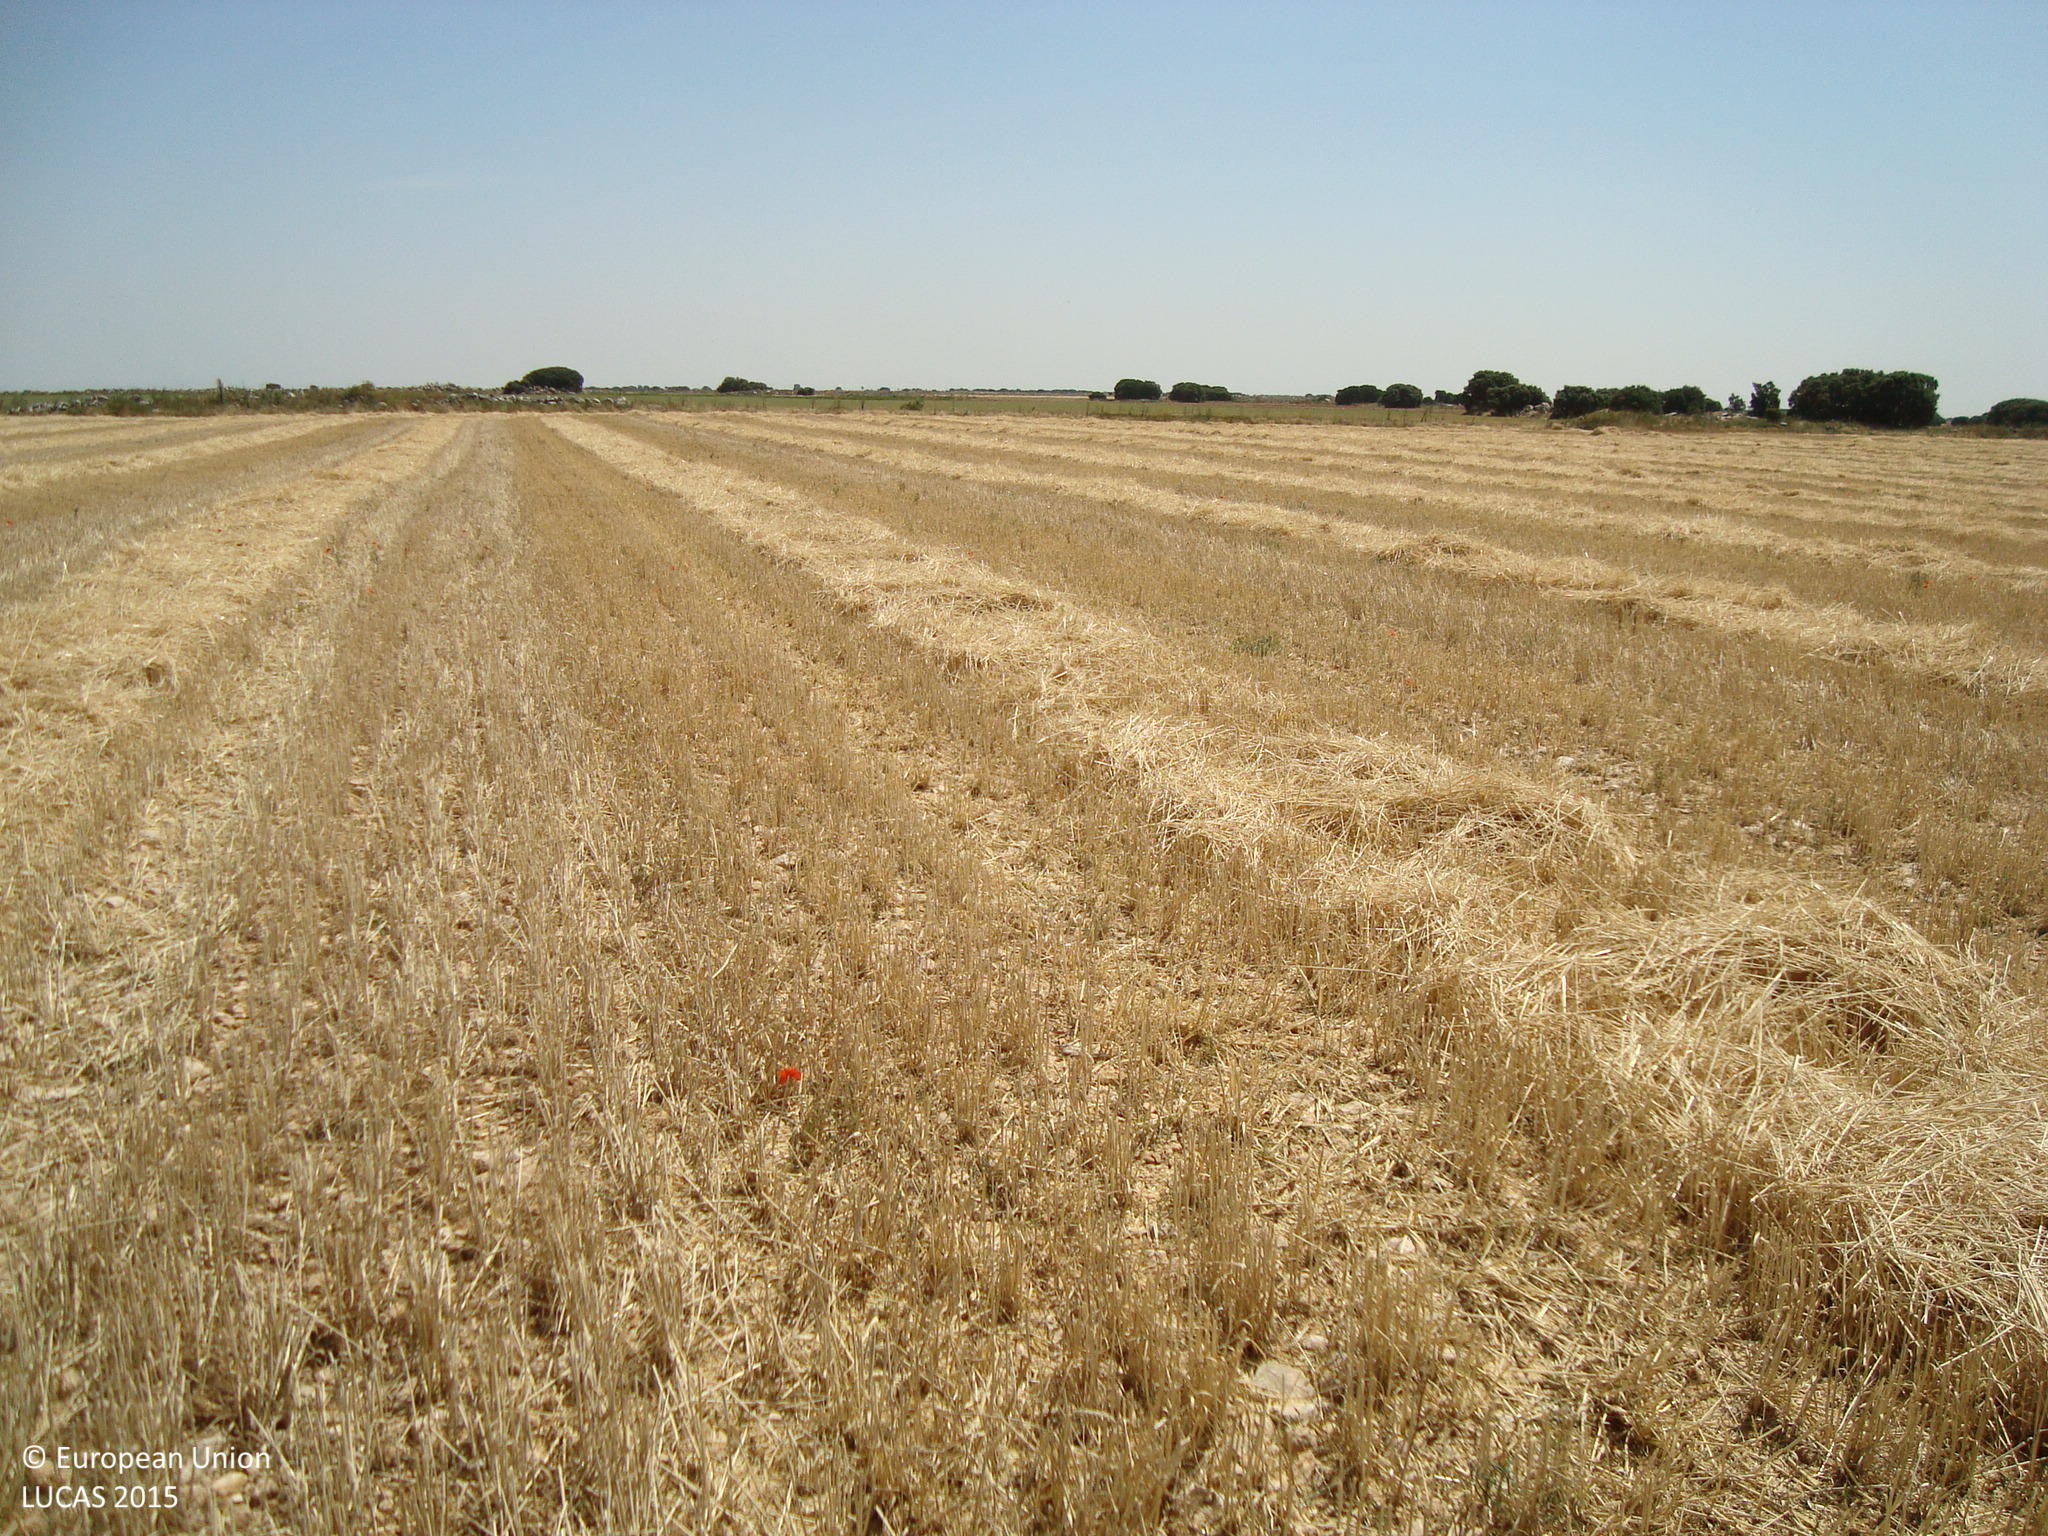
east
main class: Cropland
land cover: Common wheat
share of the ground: > 75 %
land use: Agriculture (excluding fallow land and kitchen gardens)
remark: Harvested field
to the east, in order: Common wheat; Tracks; Grass margins; Dry pulses
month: July
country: ES
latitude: 41.8252
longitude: -4.1116
